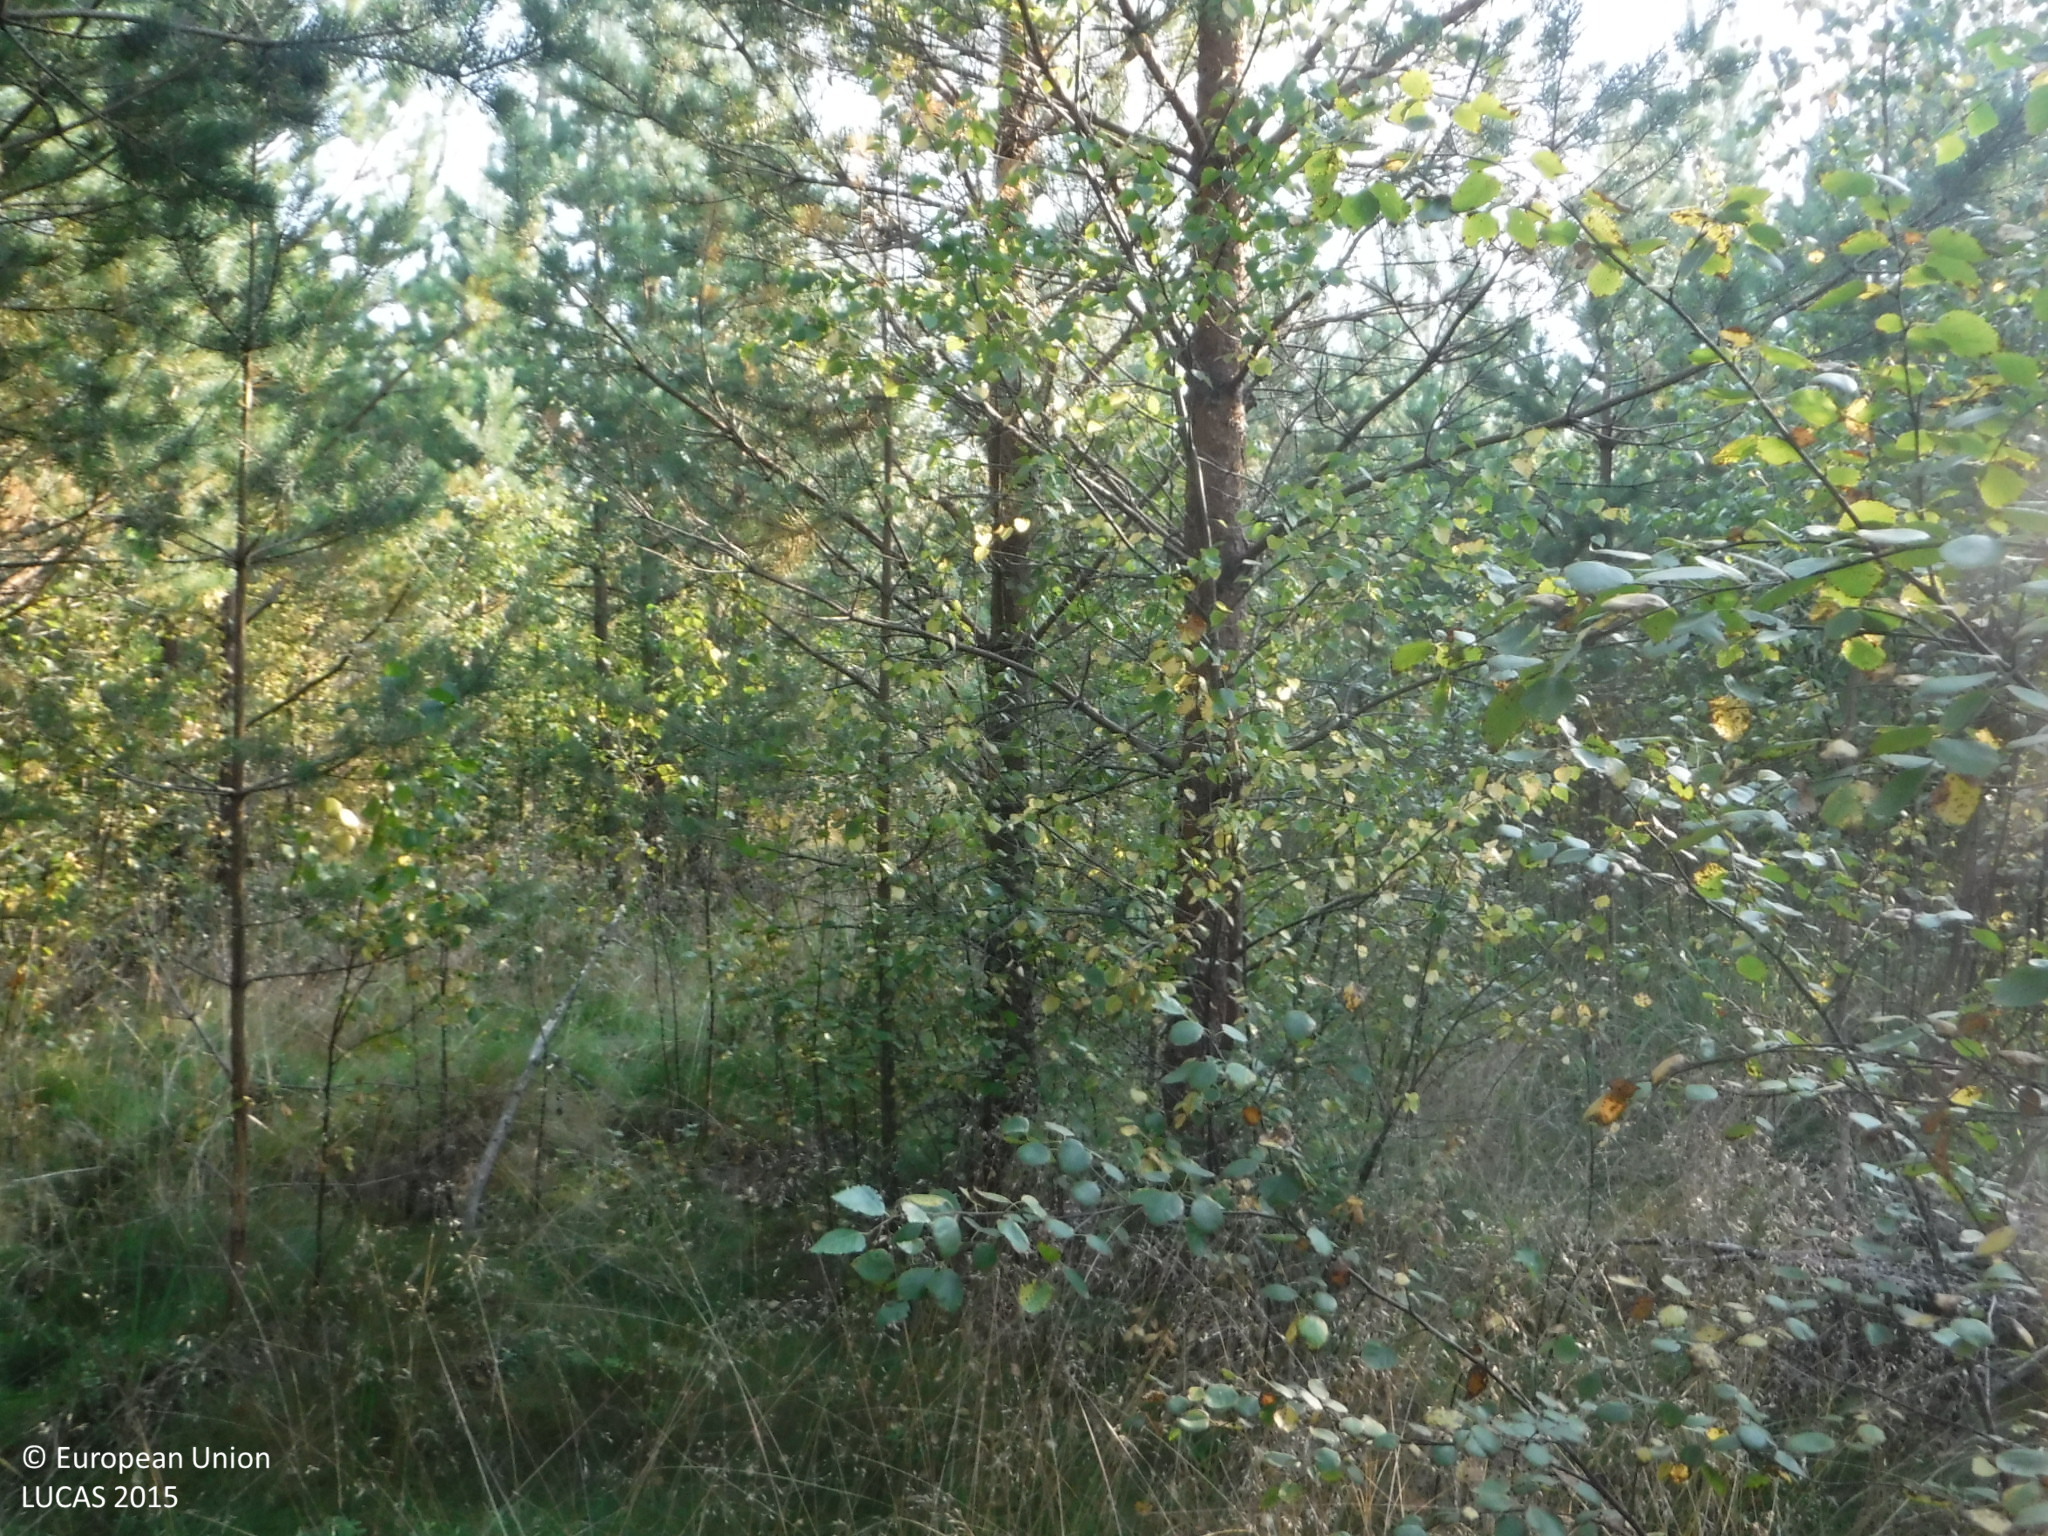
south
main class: Woodland
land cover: Pine dominated coniferous woodland
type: boreal forest
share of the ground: 25 - 50 %
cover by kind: herbaceous plants 50 %, coniferous forest trees 30 %, shrubs 10 %, broadleaved forest trees 5 %, lichens and mosses 5 %
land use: Forestry
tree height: > 5 m
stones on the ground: < 10 %
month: August
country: FI
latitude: 61.2559
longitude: 23.0287
